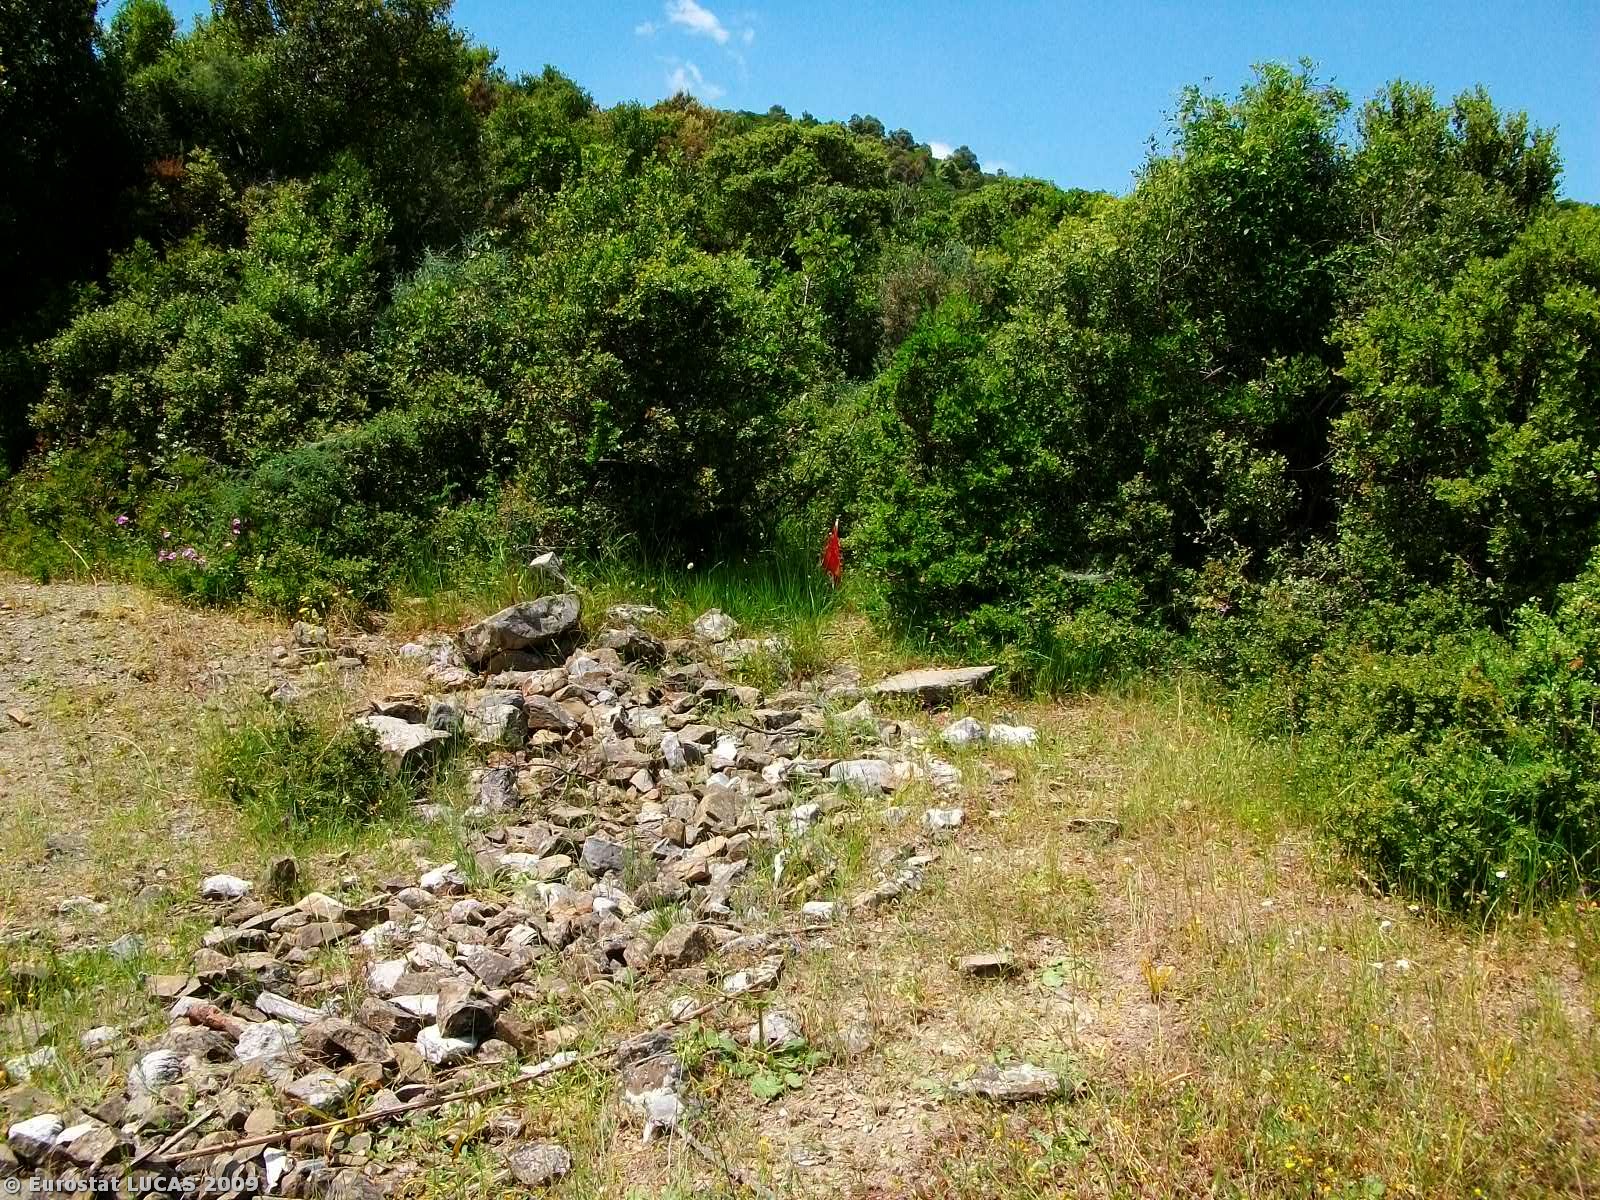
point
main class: Shrubland
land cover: Shrubland with sparse tree cover
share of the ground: > 75 %
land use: Agriculture (excluding fallow land and kitchen gardens)
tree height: > 5 m
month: May
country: GR
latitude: 38.6726
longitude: 21.5226
